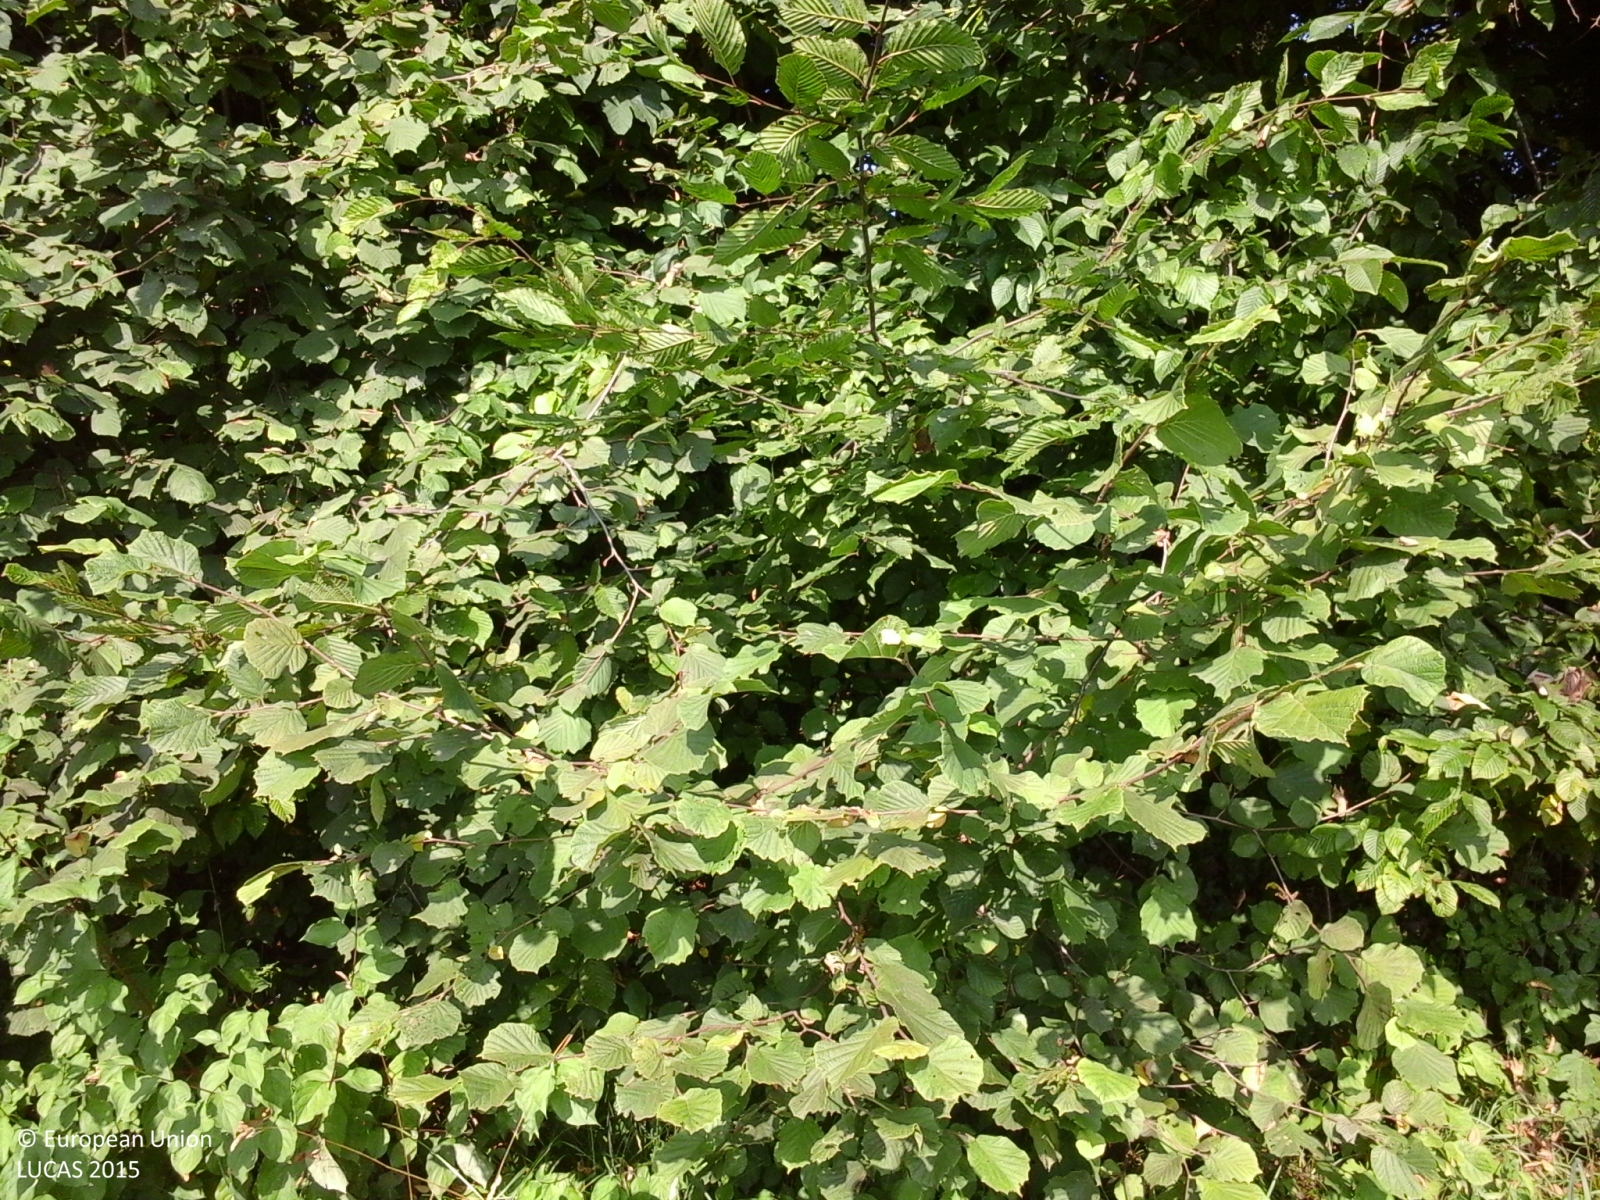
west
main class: Grassland
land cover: Grassland without tree/shrub cover
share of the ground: > 75 %
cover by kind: herbaceous plants 100 %
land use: Agriculture (excluding fallow land and kitchen gardens)
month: July
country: IT
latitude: 46.1307
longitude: 12.1846
